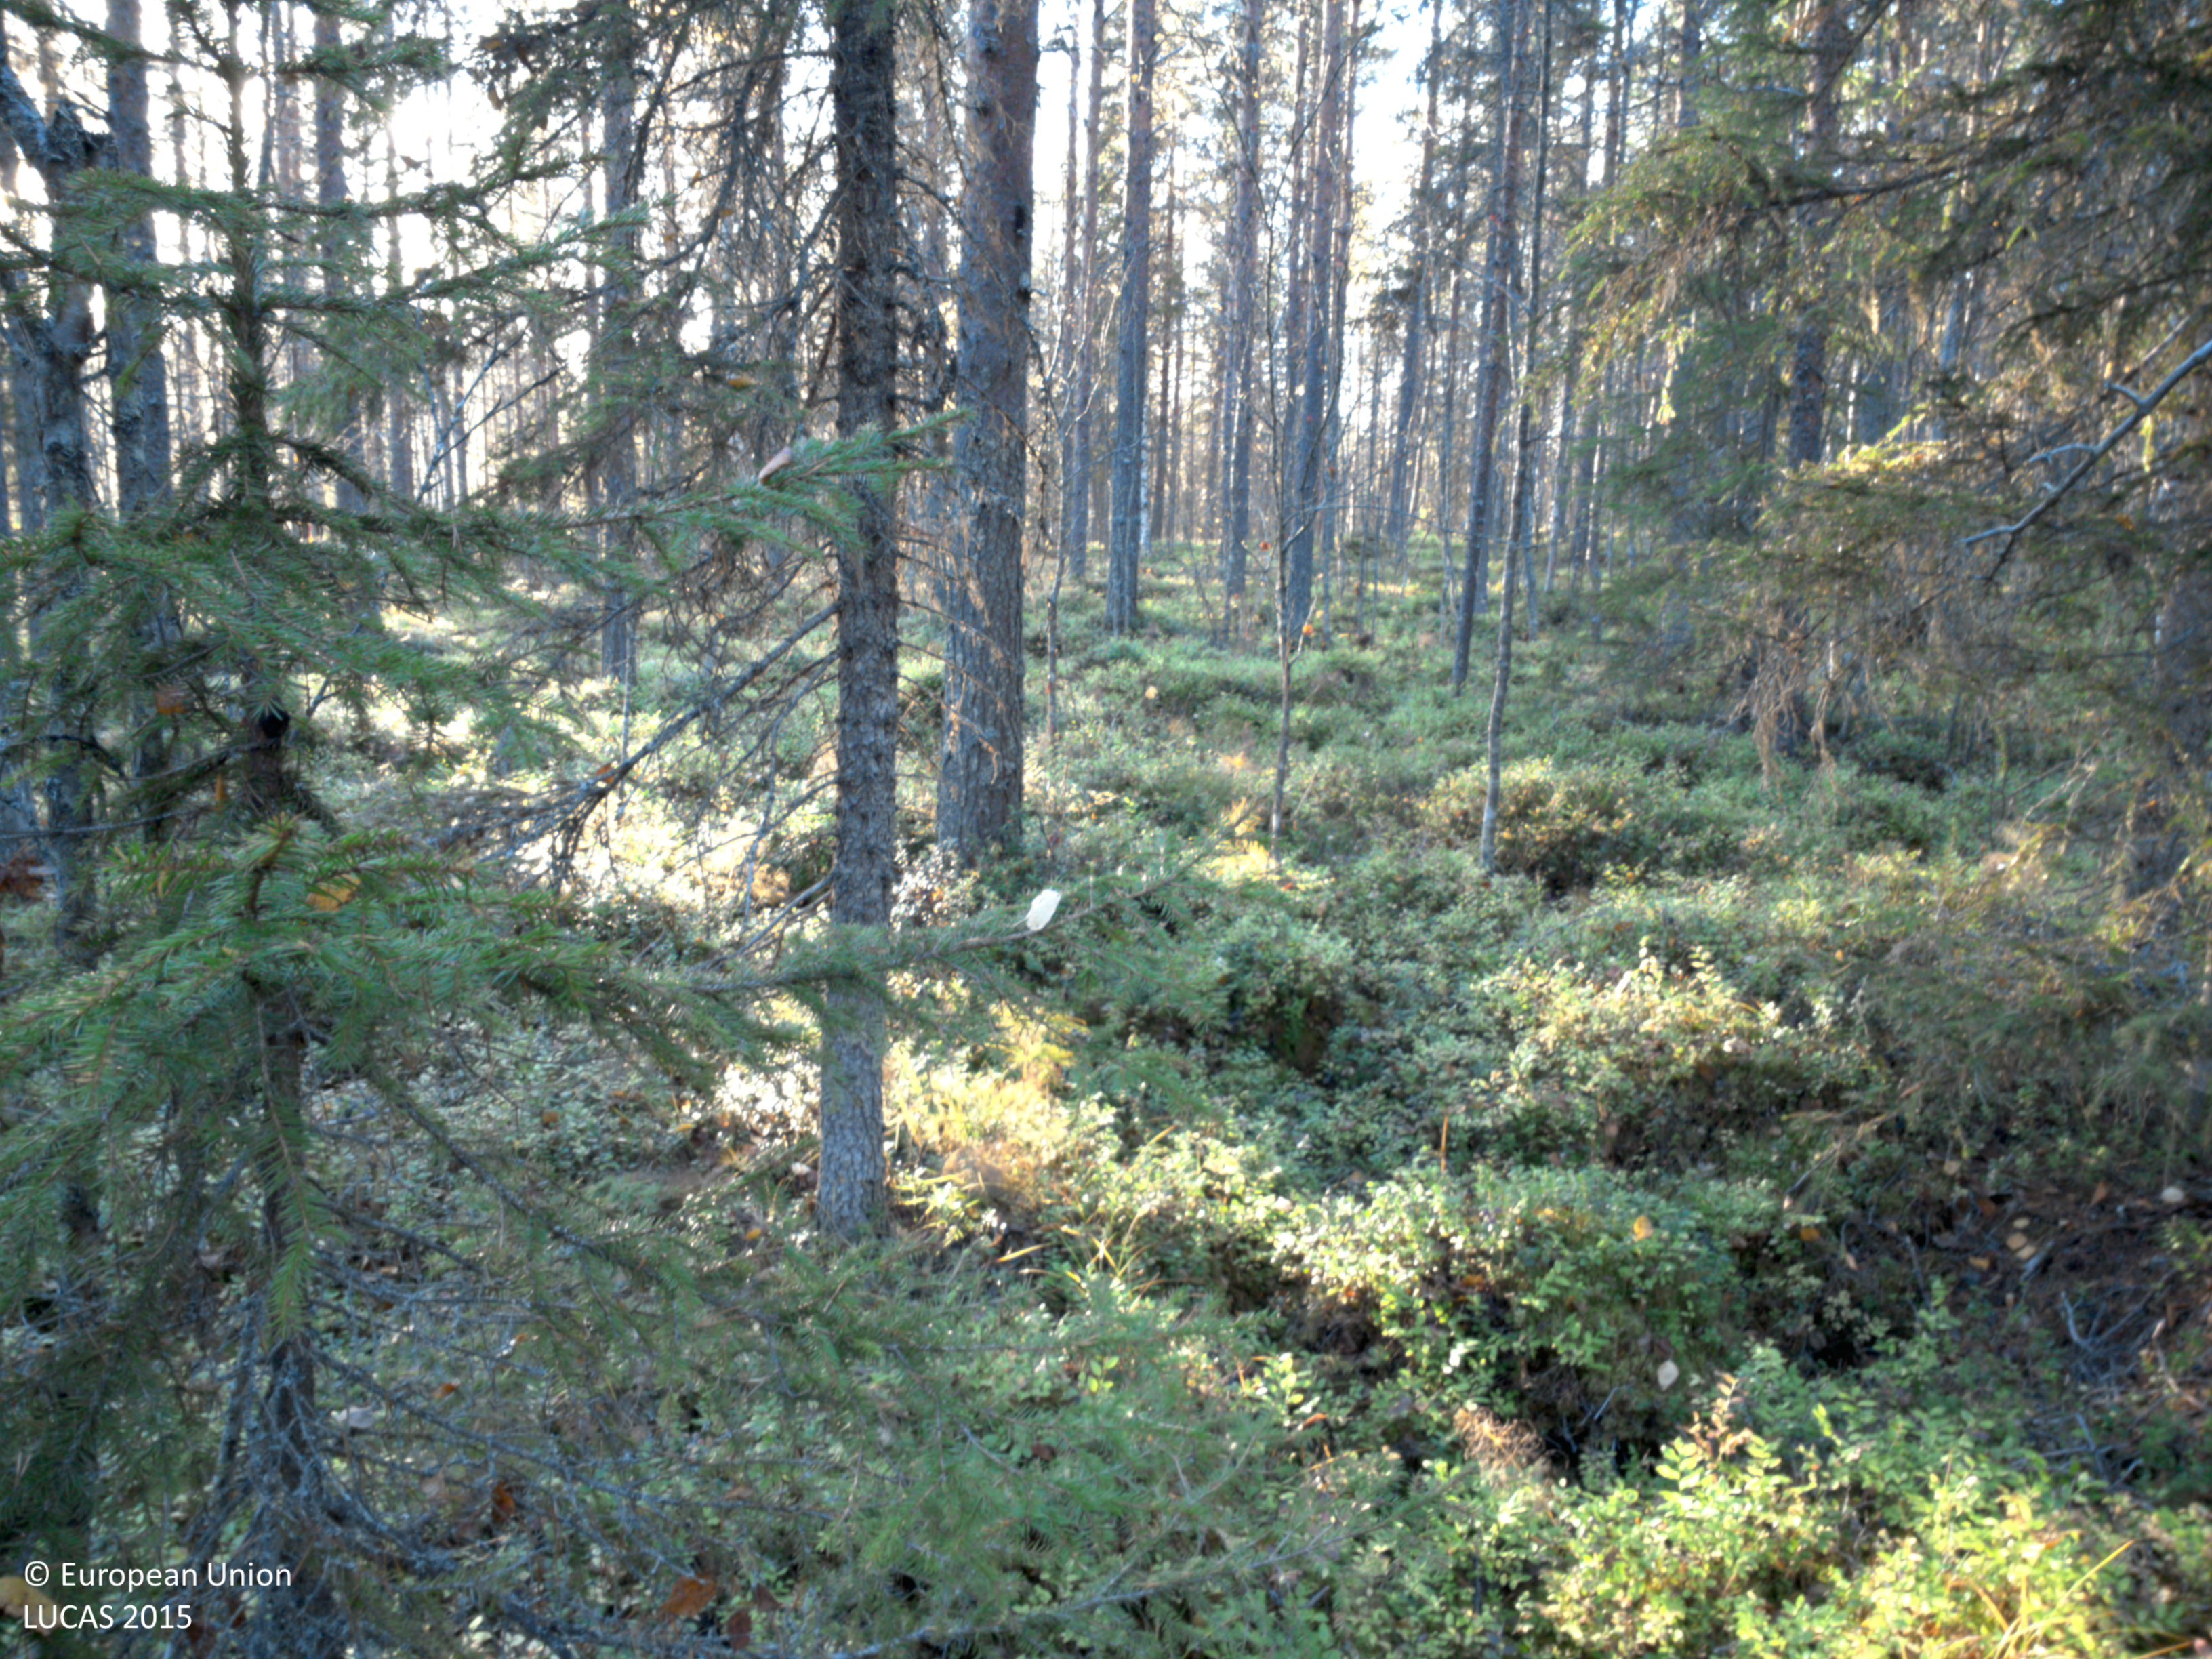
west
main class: Woodland
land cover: Pine dominated mixed woodland
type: boreal forest
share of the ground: 50 - 75 %
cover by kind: coniferous forest trees 45 %, shrubs 40 %, broadleaved forest trees 15 %
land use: Forestry
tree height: > 5 m
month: September
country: SE
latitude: 64.9430
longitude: 18.3233
